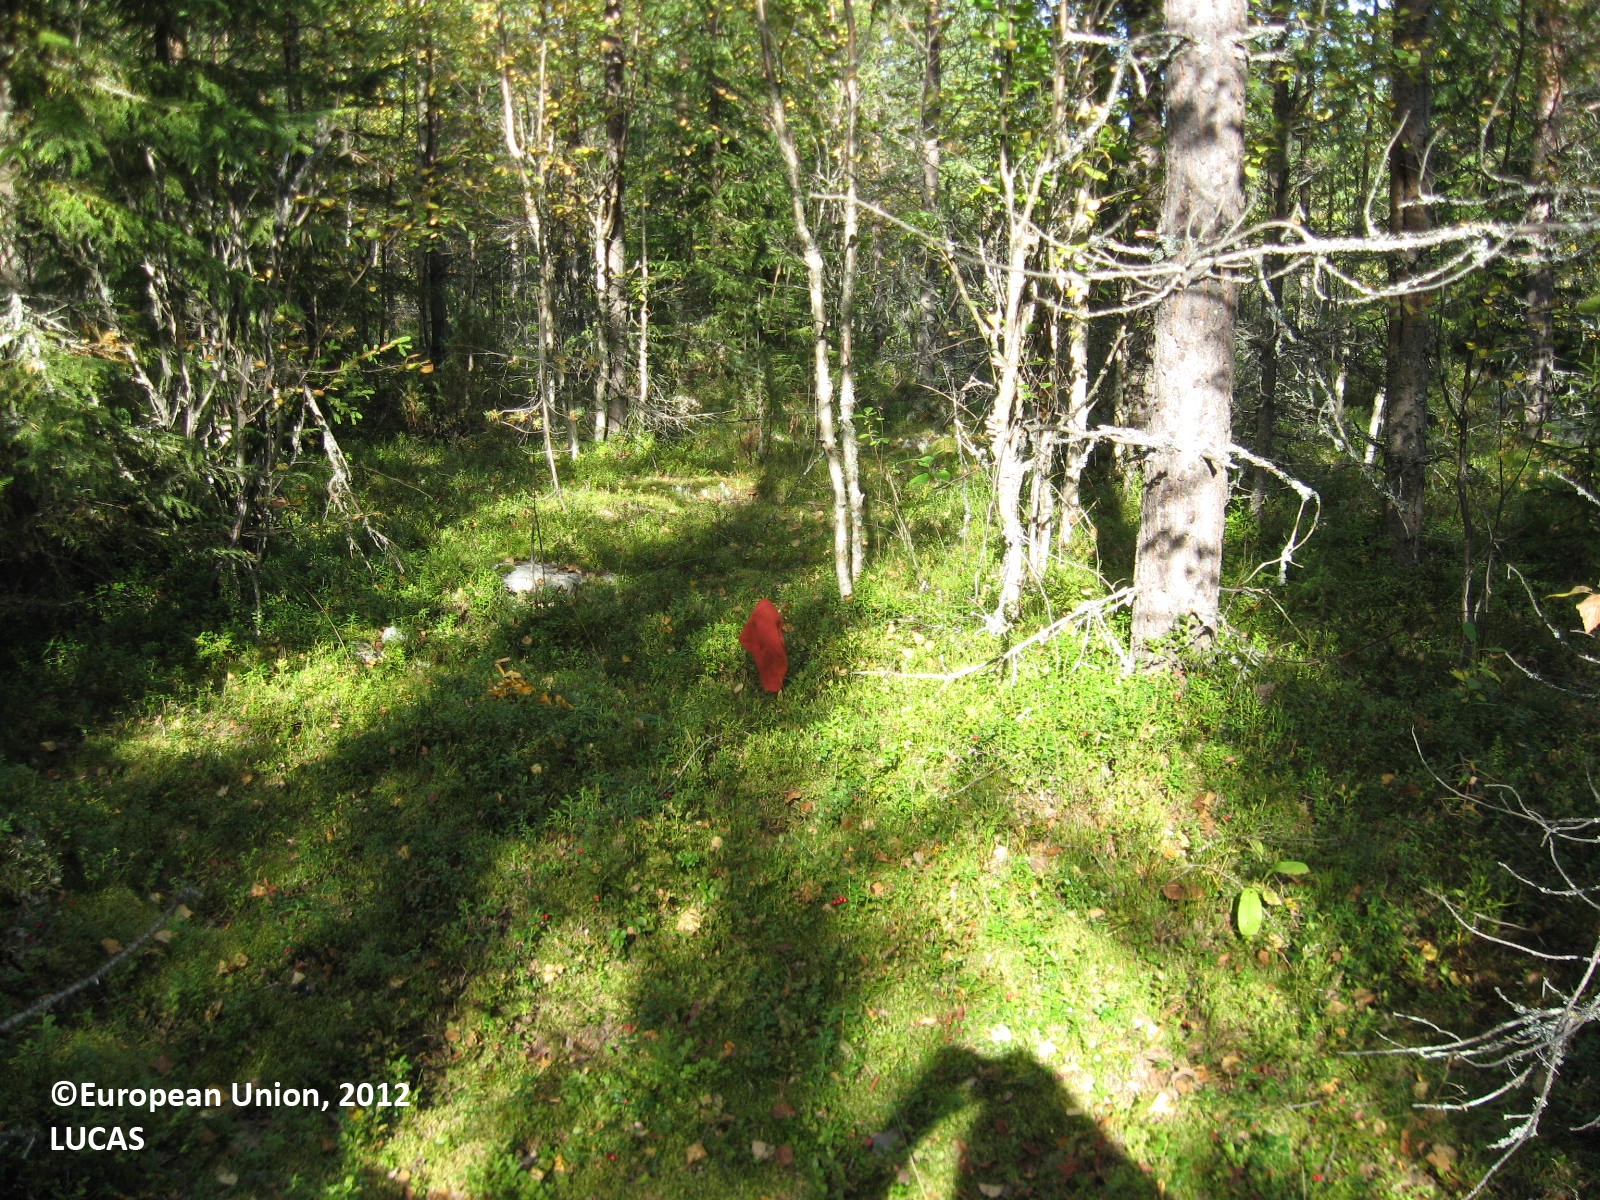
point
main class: Woodland
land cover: Other mixed woodland
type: boreal forest
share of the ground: > 75 %
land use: Forestry
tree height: > 5 m
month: August
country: FI
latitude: 63.8858
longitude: 28.7014
